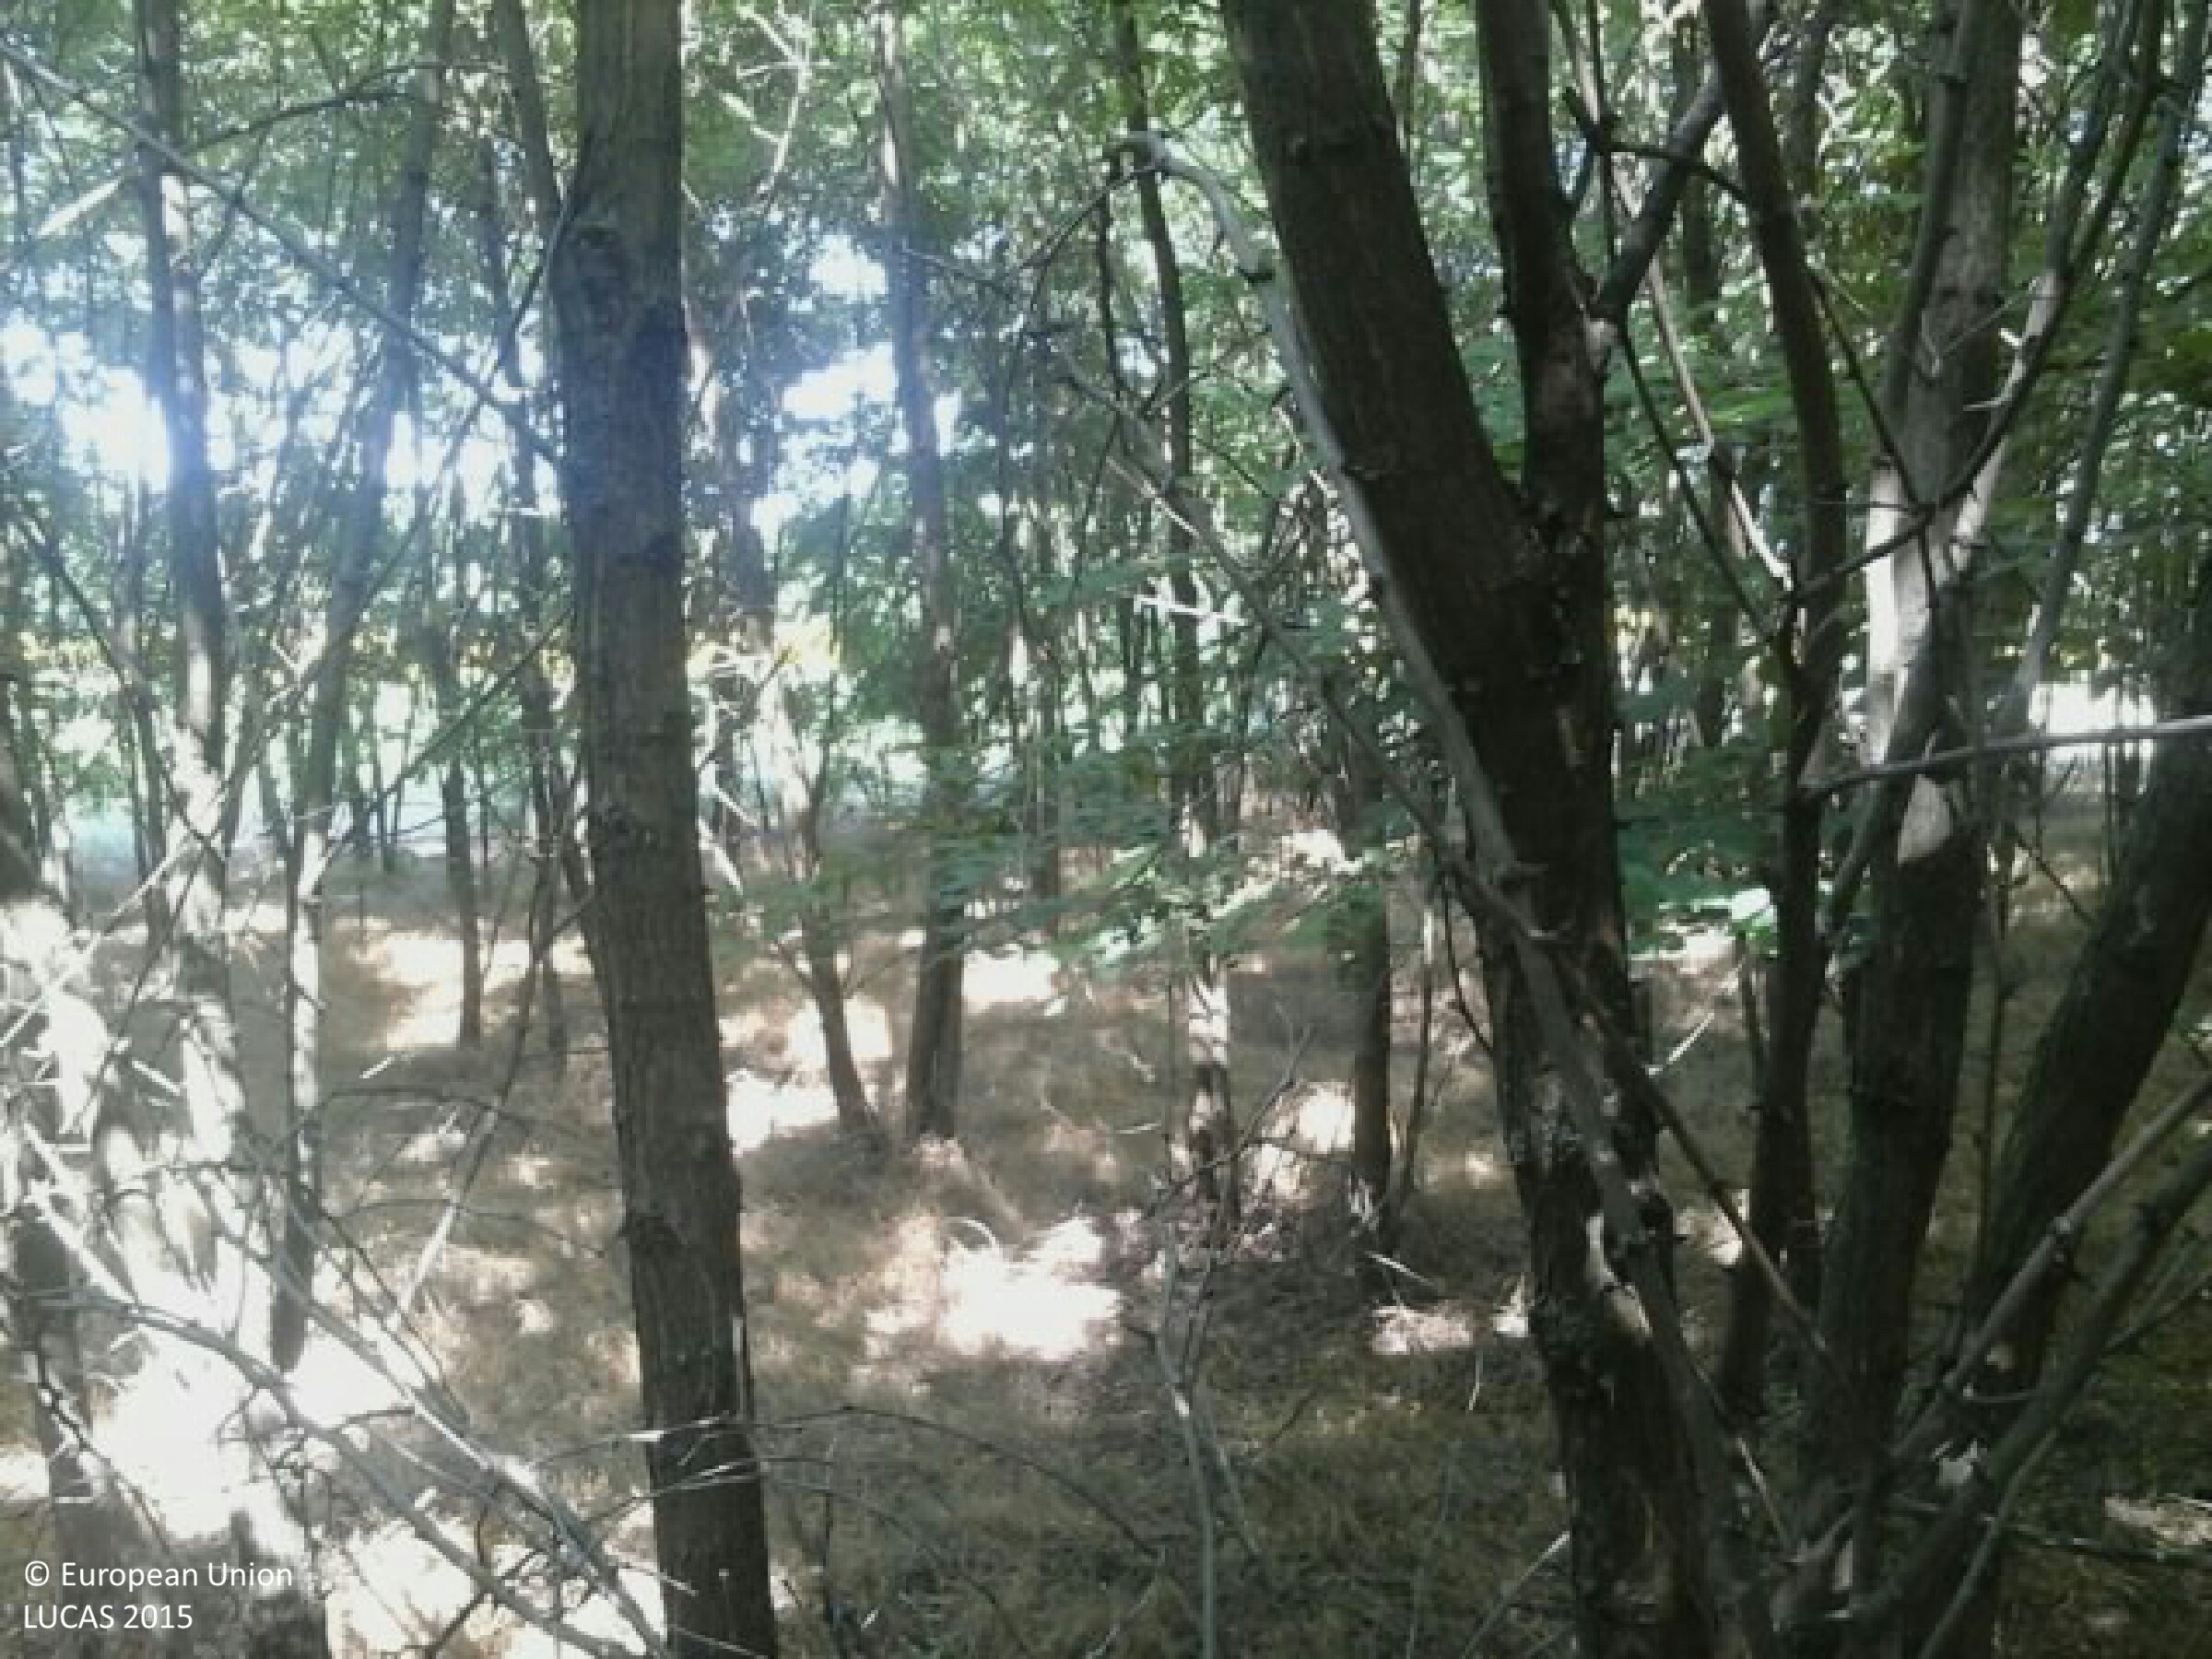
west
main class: Woodland
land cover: Broadleaved woodland
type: mesophytic deciduous forest
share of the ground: > 75 %
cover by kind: broadleaved forest trees 75 %, herbaceous plants 25 %
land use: Forestry
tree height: > 5 m
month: July
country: HU
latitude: 46.7539
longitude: 18.9556
